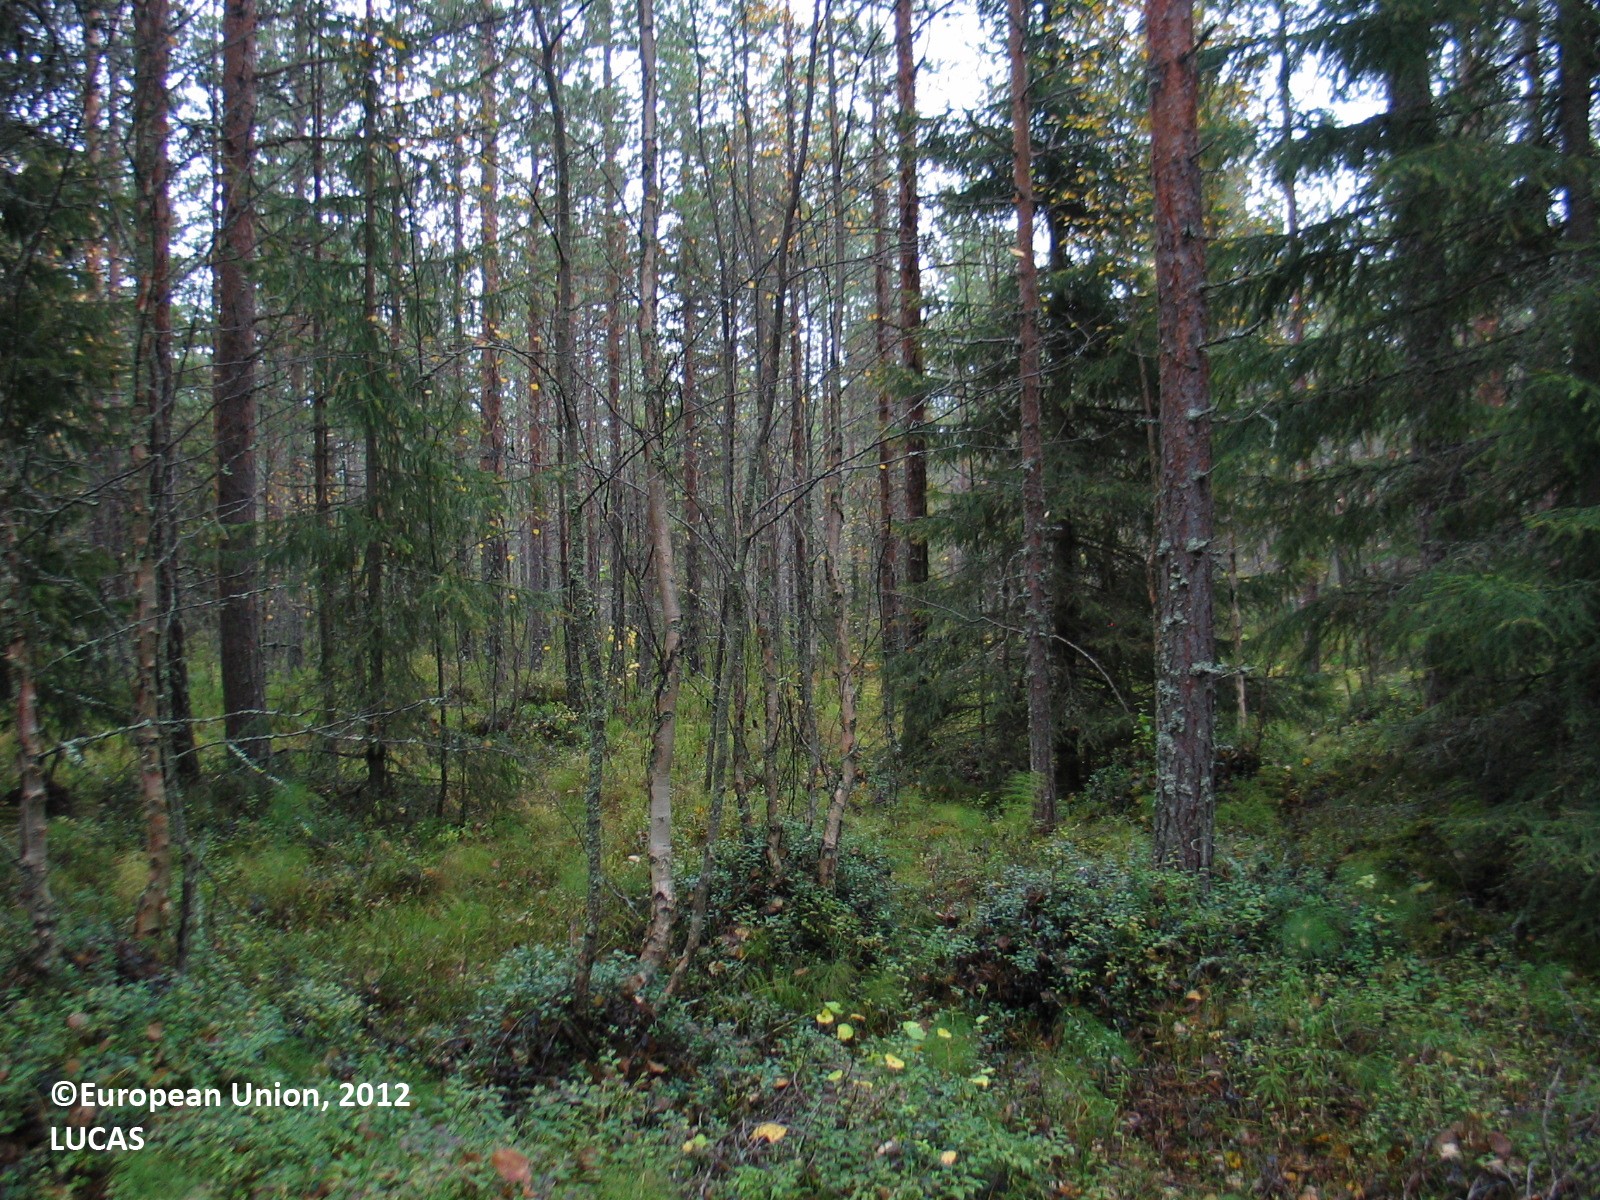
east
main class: Woodland
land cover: Pine dominated coniferous woodland
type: mire and swamp forests
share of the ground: 50 - 75 %
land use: Forestry
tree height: > 5 m
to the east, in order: Pine dominated coniferous woodland; Ditches and canals; Groves; Tracks; Pine dominated coniferous woodland; Ditches and canals; Pine dominated coniferous woodland
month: September
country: FI
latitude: 65.3824
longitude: 25.5490
